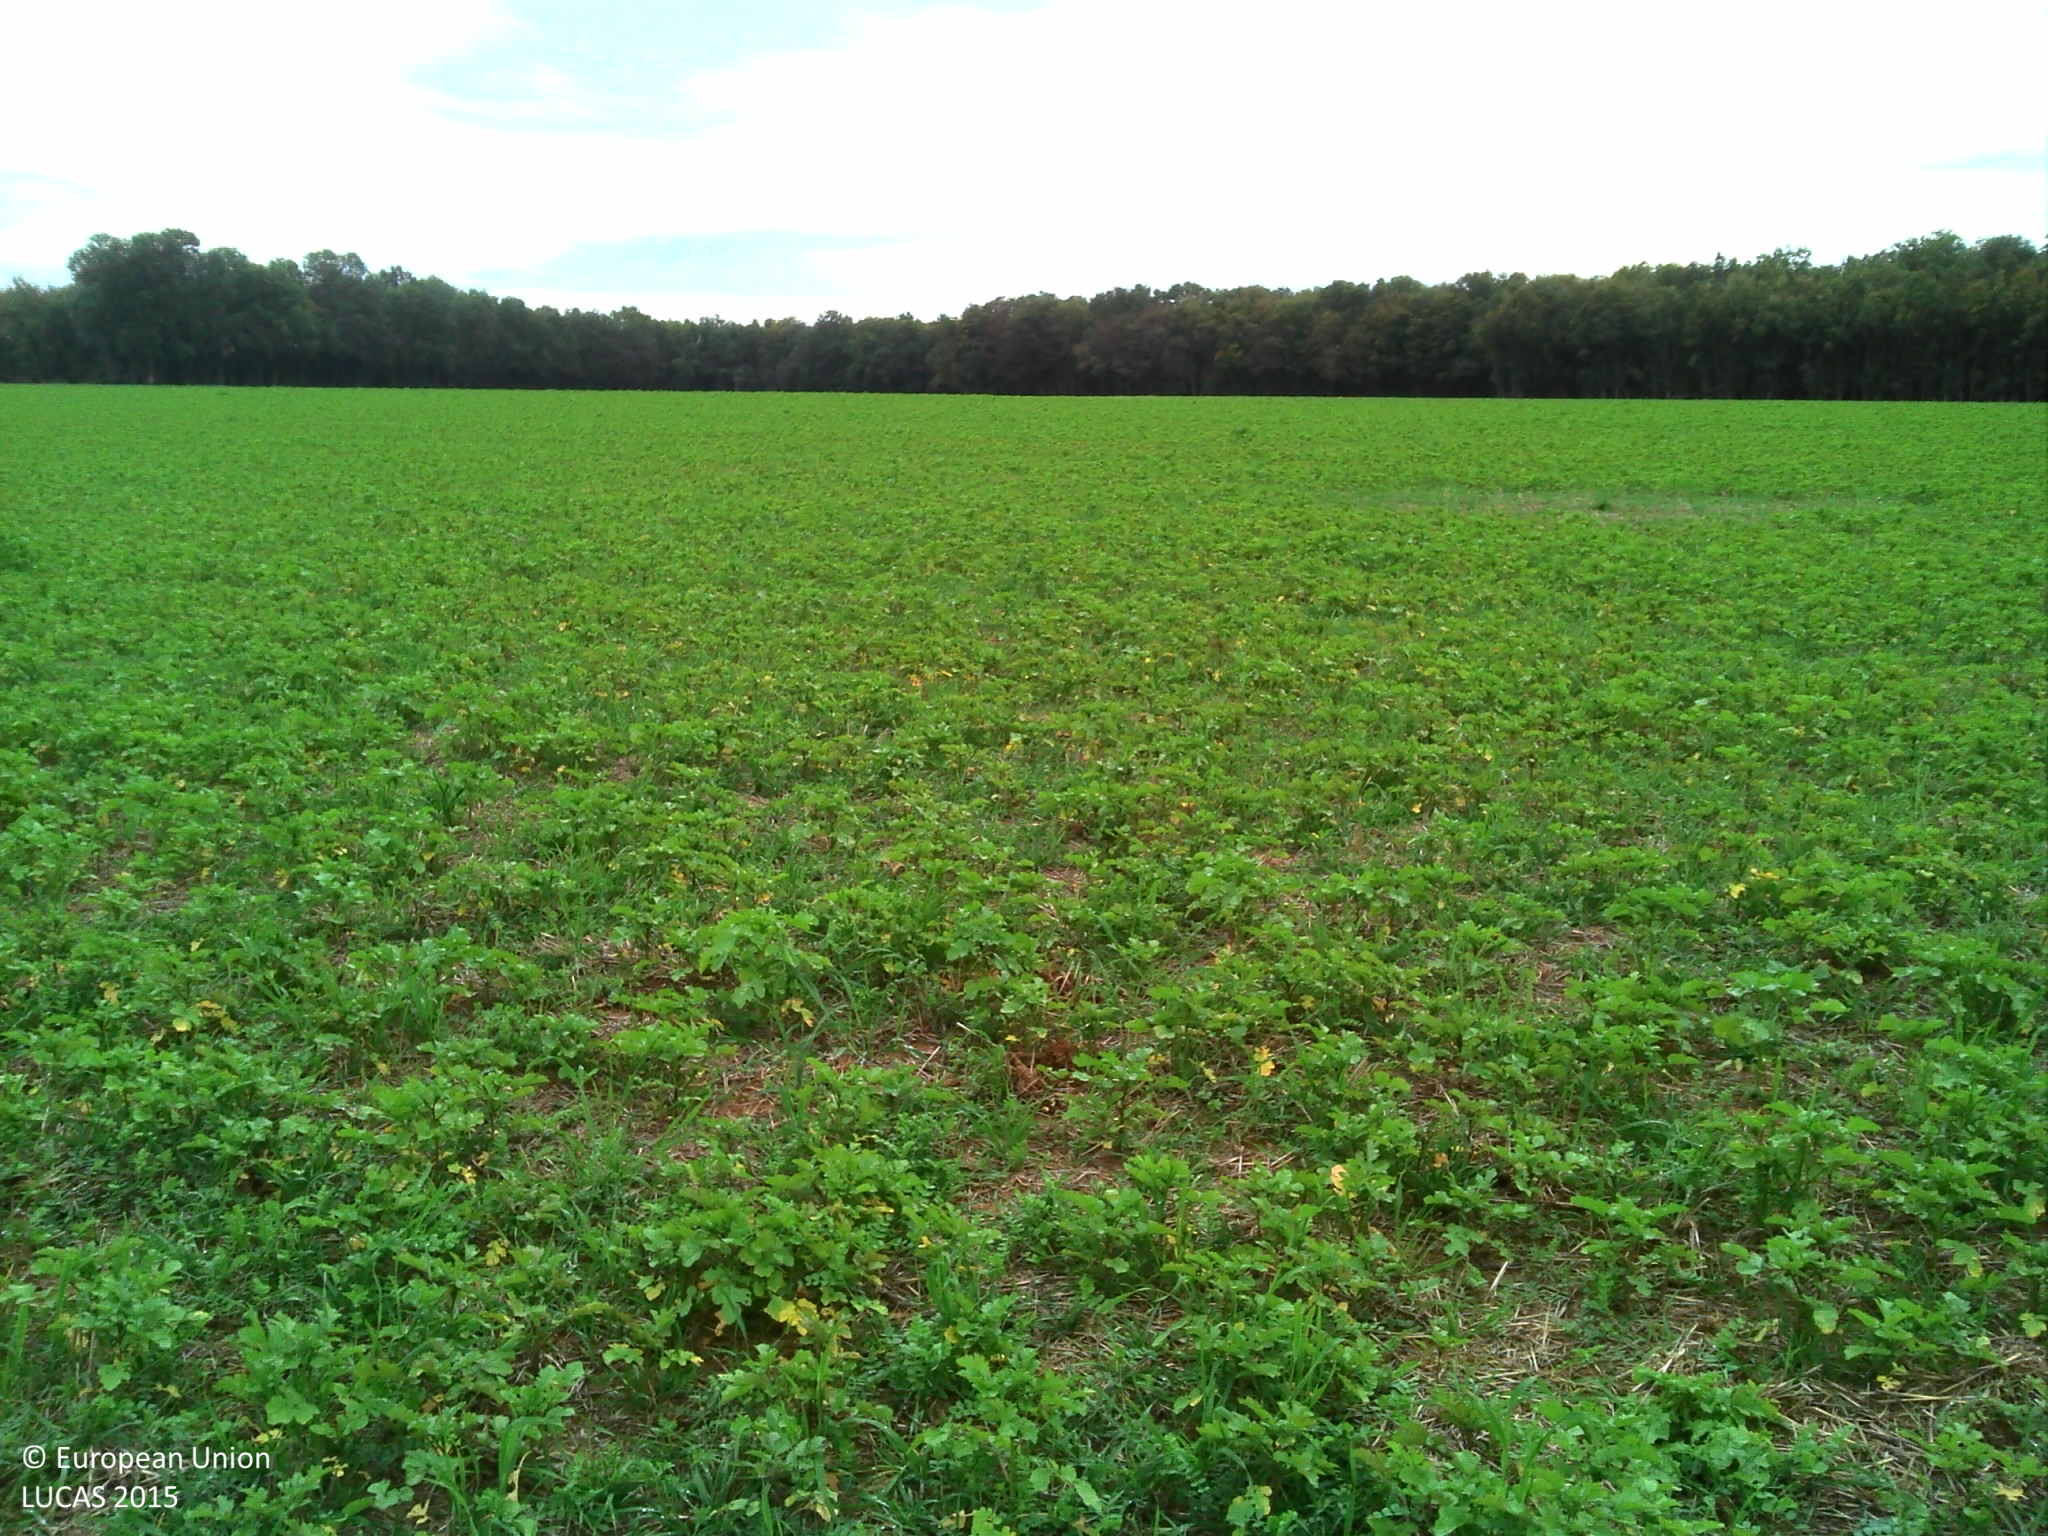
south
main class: Cropland
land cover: Other fibre and oleaginous crops
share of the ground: > 75 %
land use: Agriculture (excluding fallow land and kitchen gardens)
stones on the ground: < 10 %
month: October
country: FR
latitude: 48.0951
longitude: 4.3177
